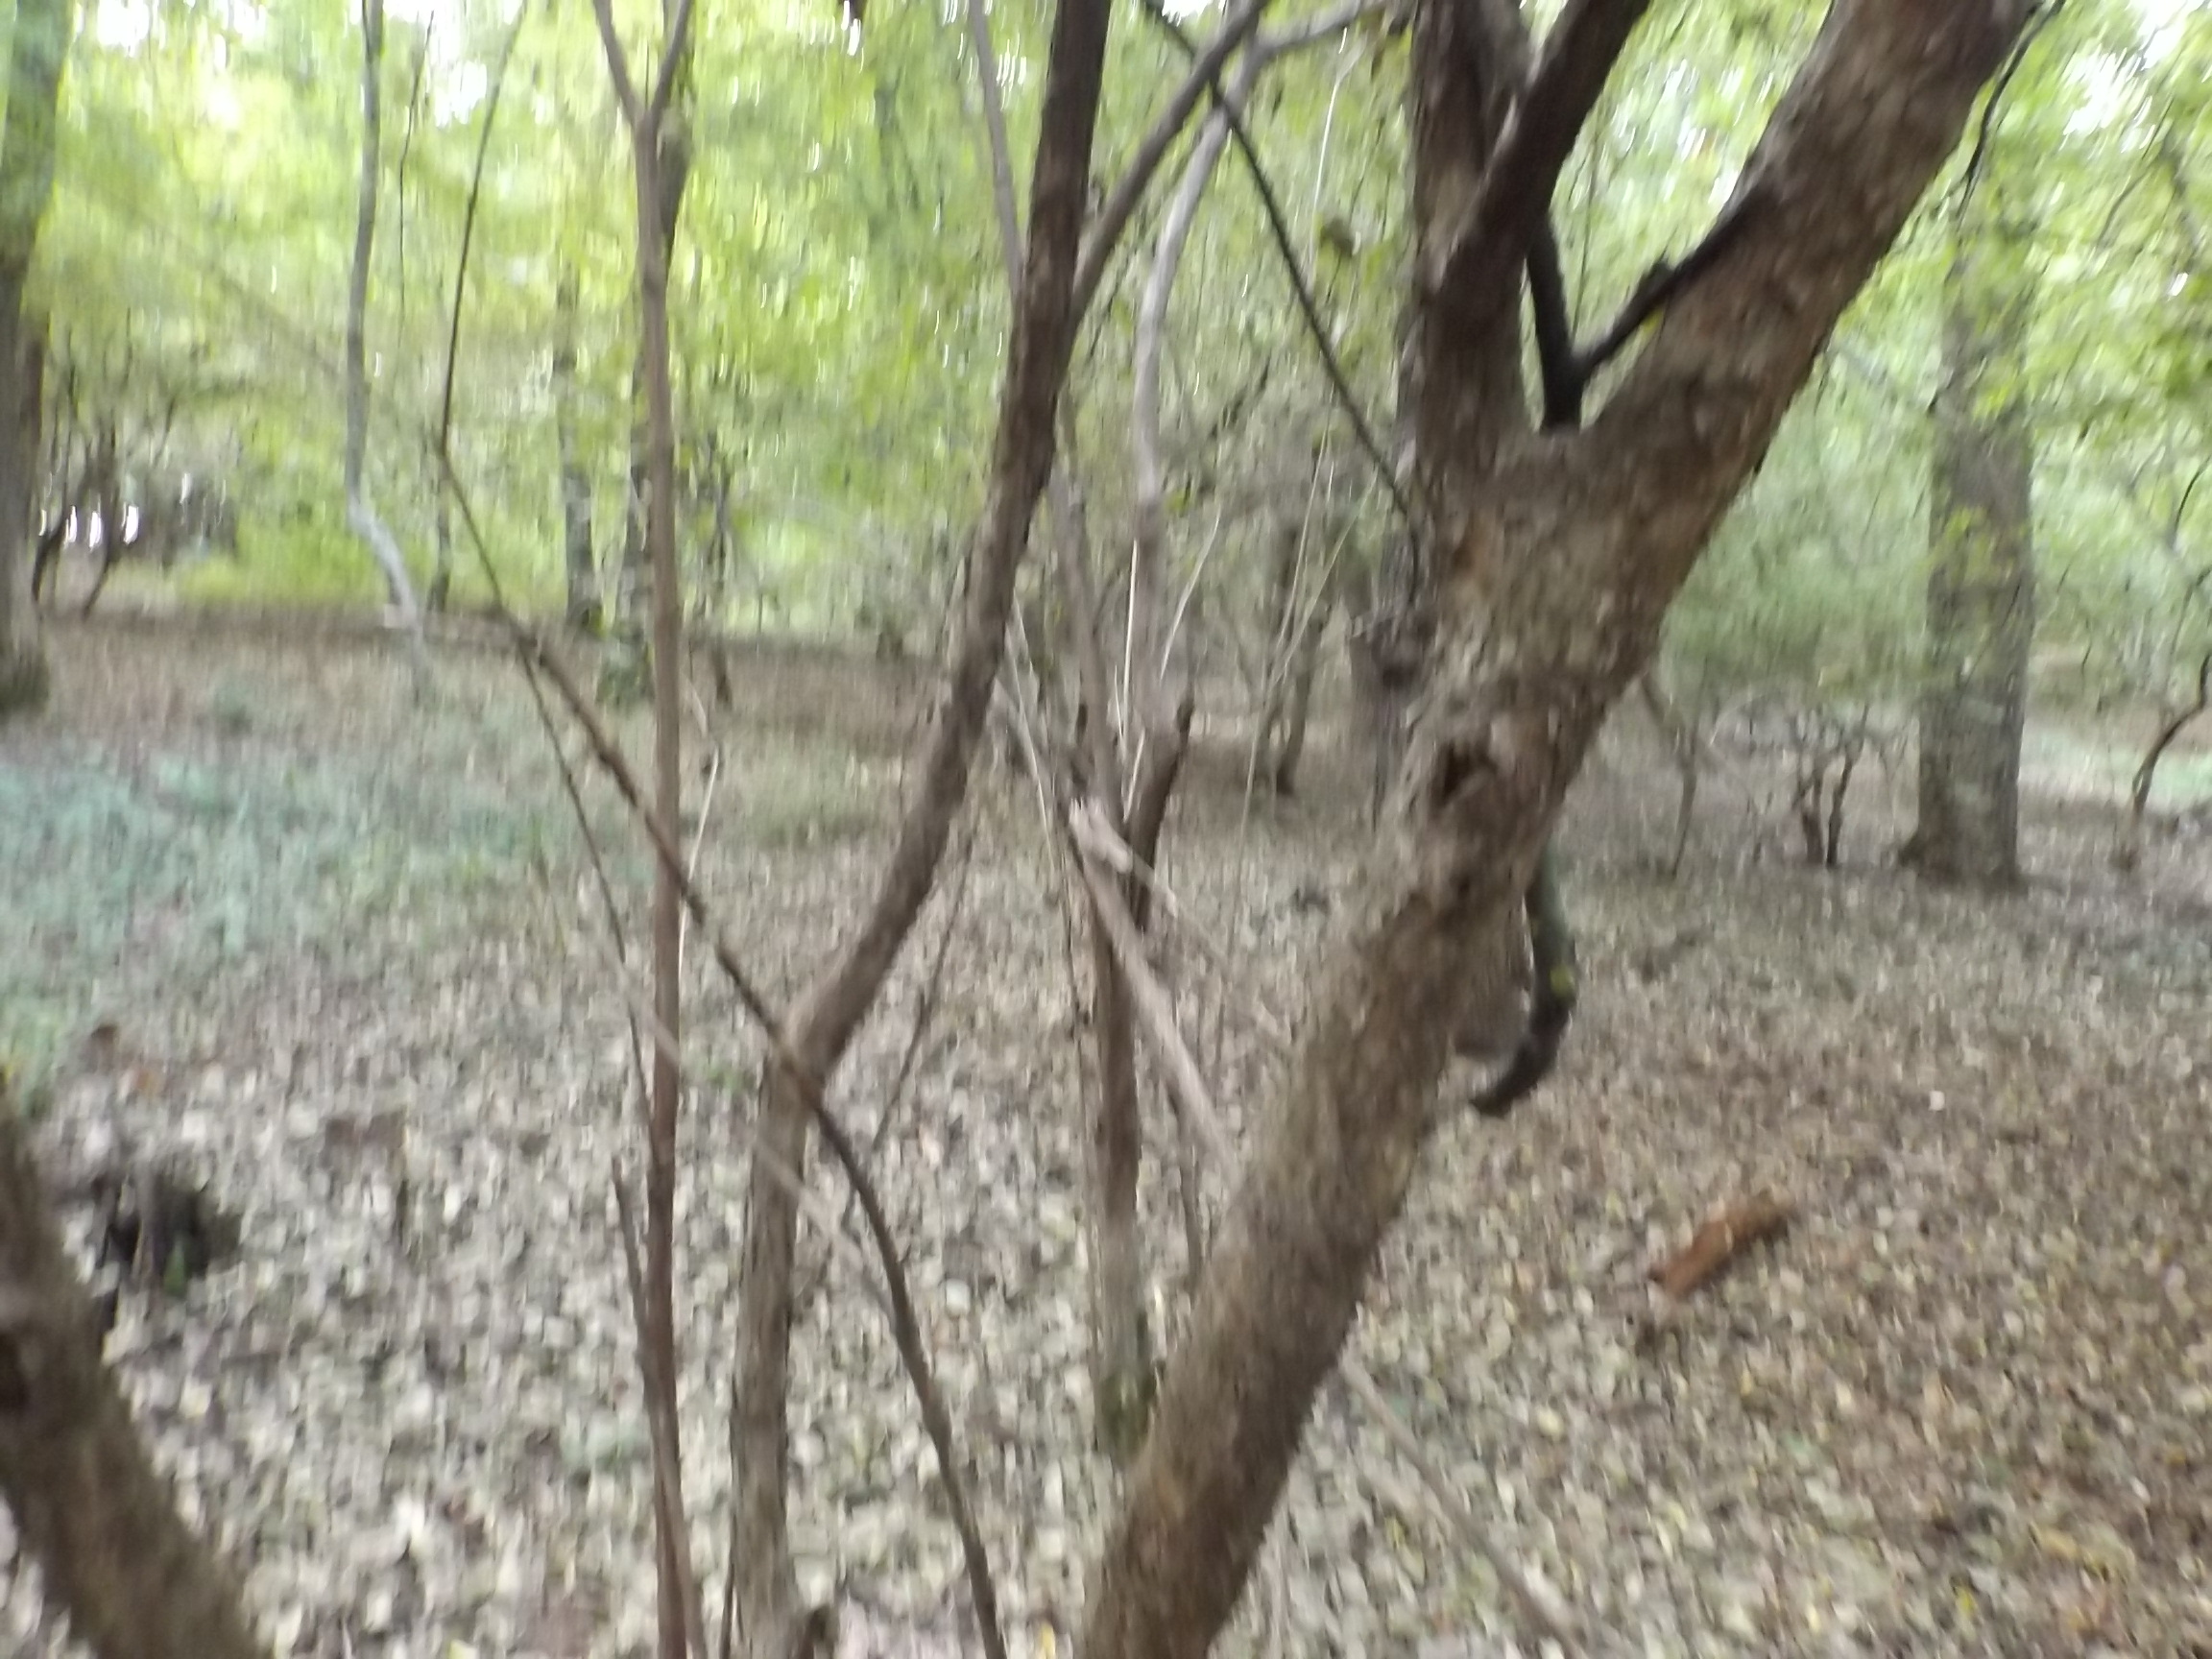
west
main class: Woodland
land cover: Broadleaved woodland
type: beech forest
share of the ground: > 75 %
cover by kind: broadleaved forest trees 100 %
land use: Forestry
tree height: > 5 m
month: October
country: BG
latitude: 43.9032
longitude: 26.7113
